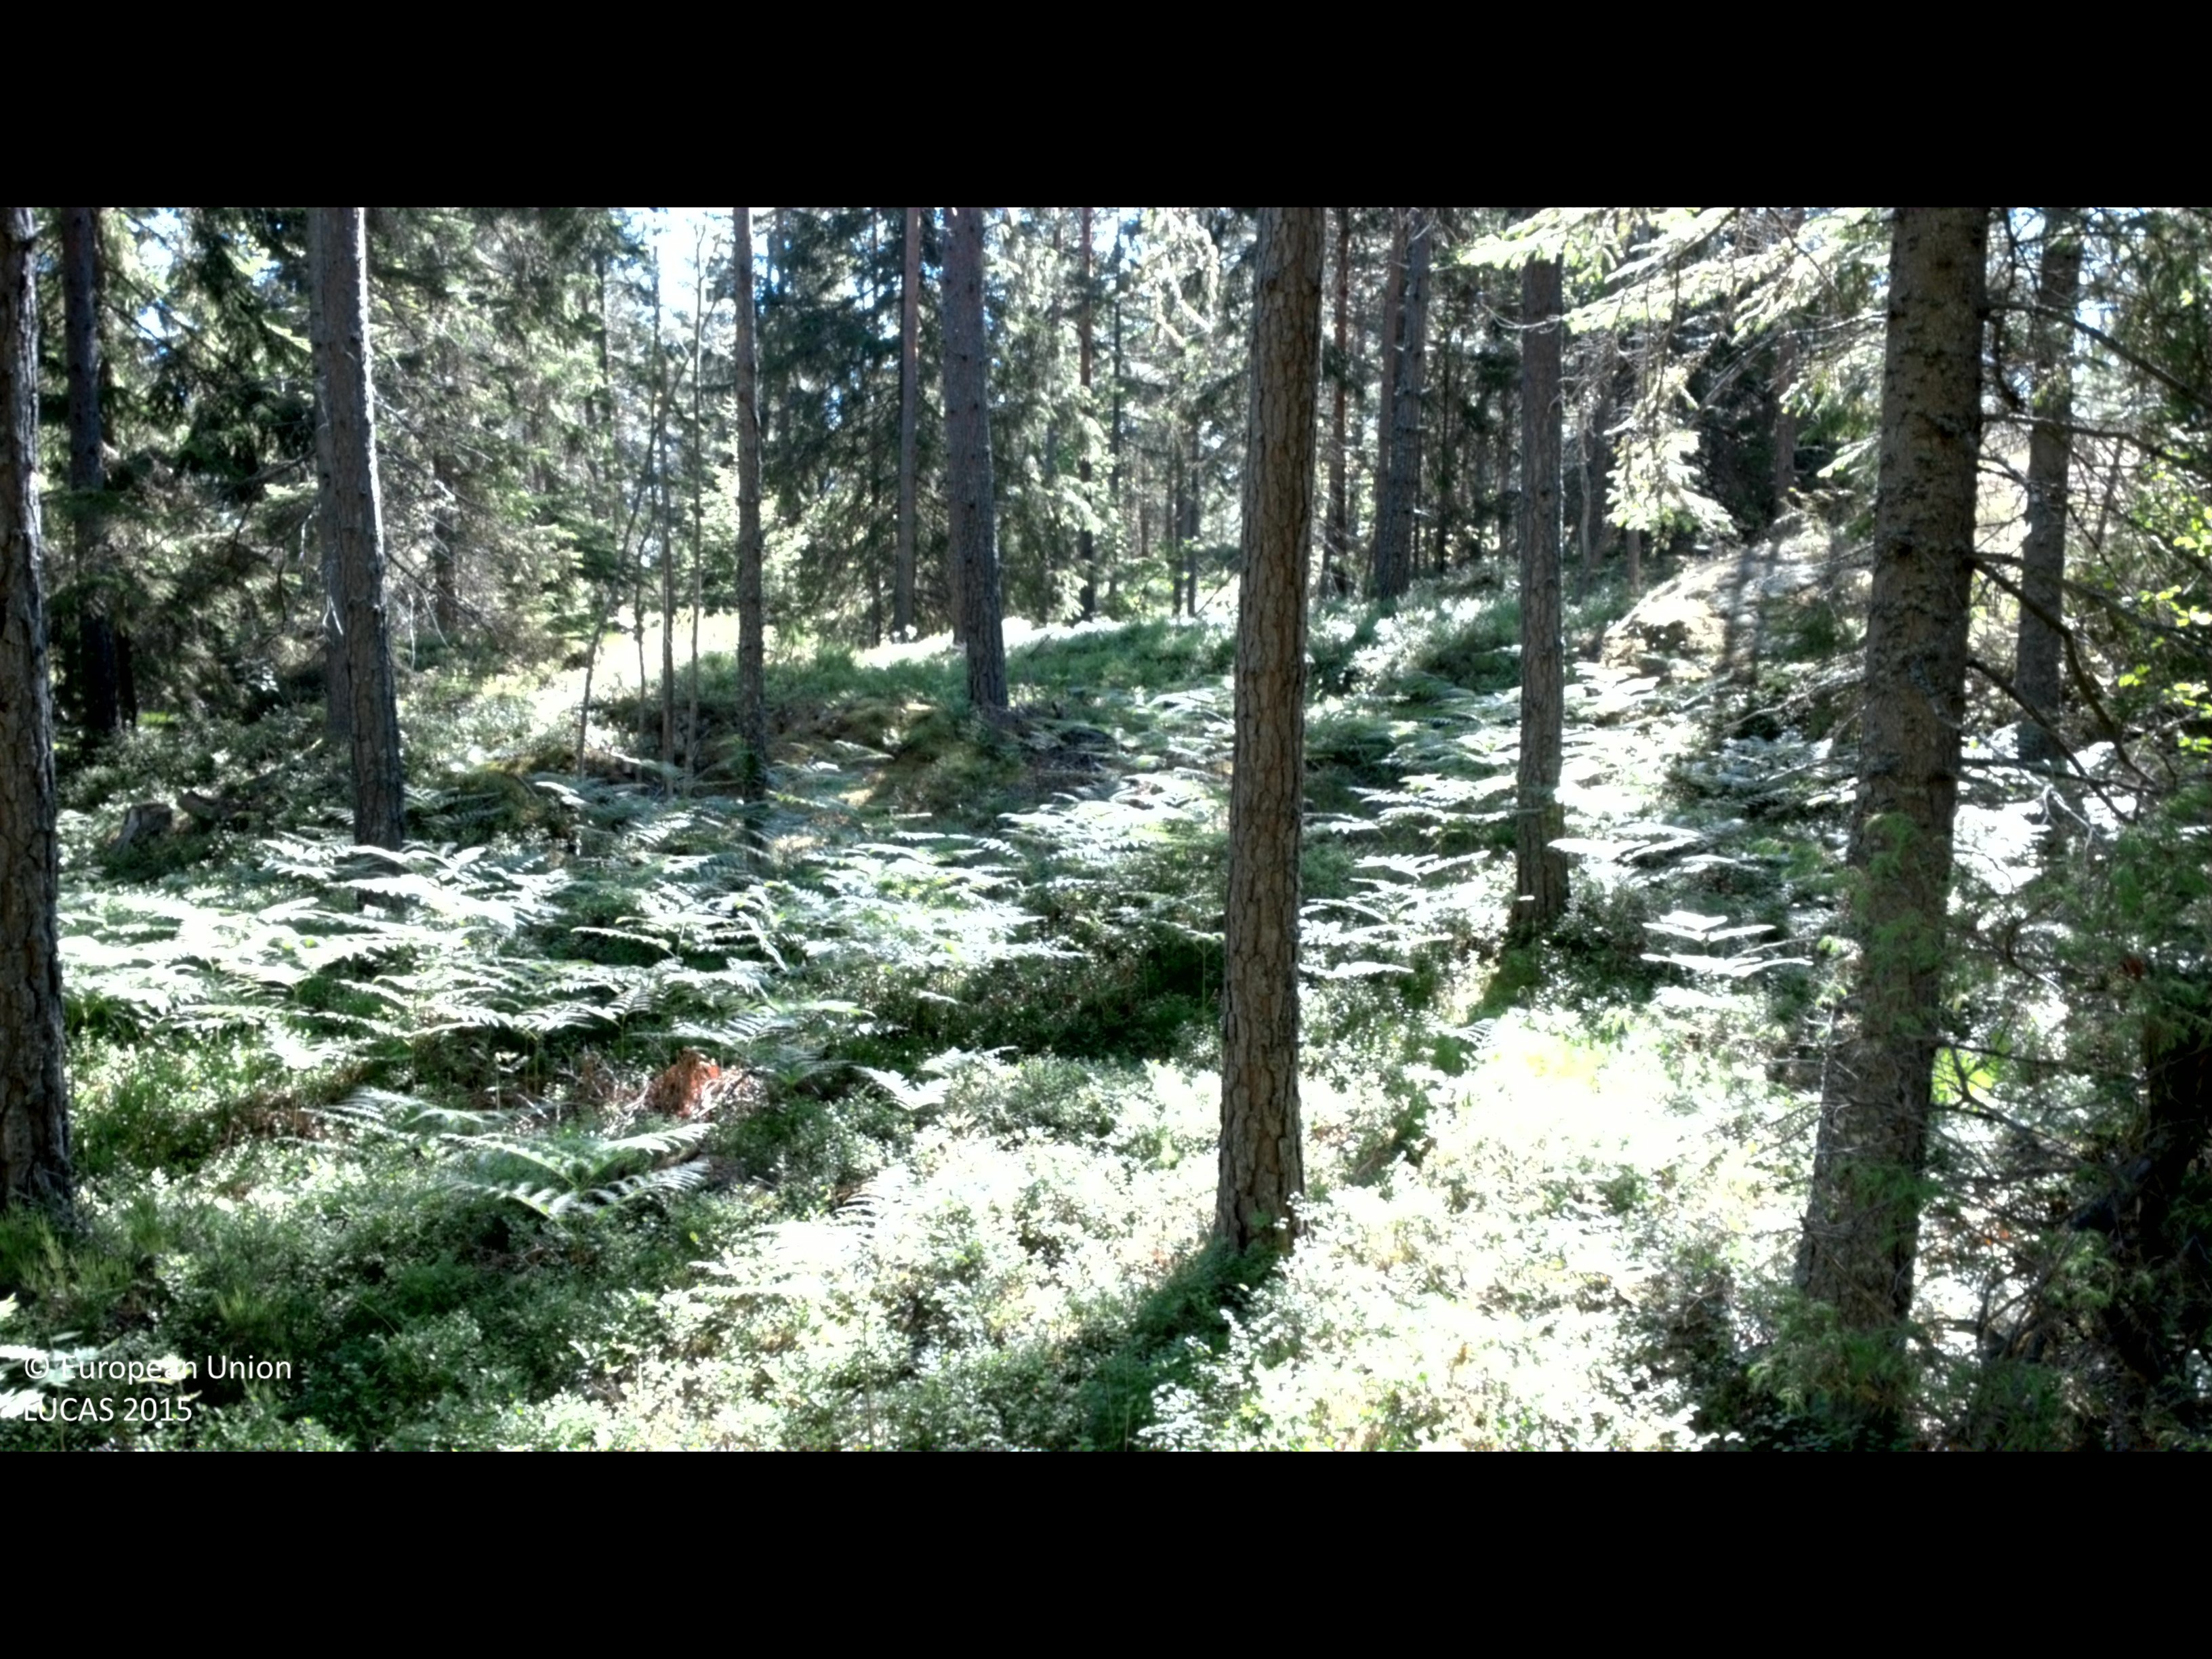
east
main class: Woodland
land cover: Other coniferous woodland
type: boreal forest
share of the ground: 50 - 75 %
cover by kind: coniferous forest trees 55 %, shrubs 25 %, broadleaved forest trees 15 %, herbaceous plants 5 %
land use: Forestry
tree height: > 5 m
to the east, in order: Other coniferous woodland; Pine dominated coniferous woodland; Other mixed woodland; Tracks; Spruce dominated mixed woodland; Rivers and streams; Other coniferous woodland
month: July
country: SE
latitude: 58.2060
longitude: 16.5147
